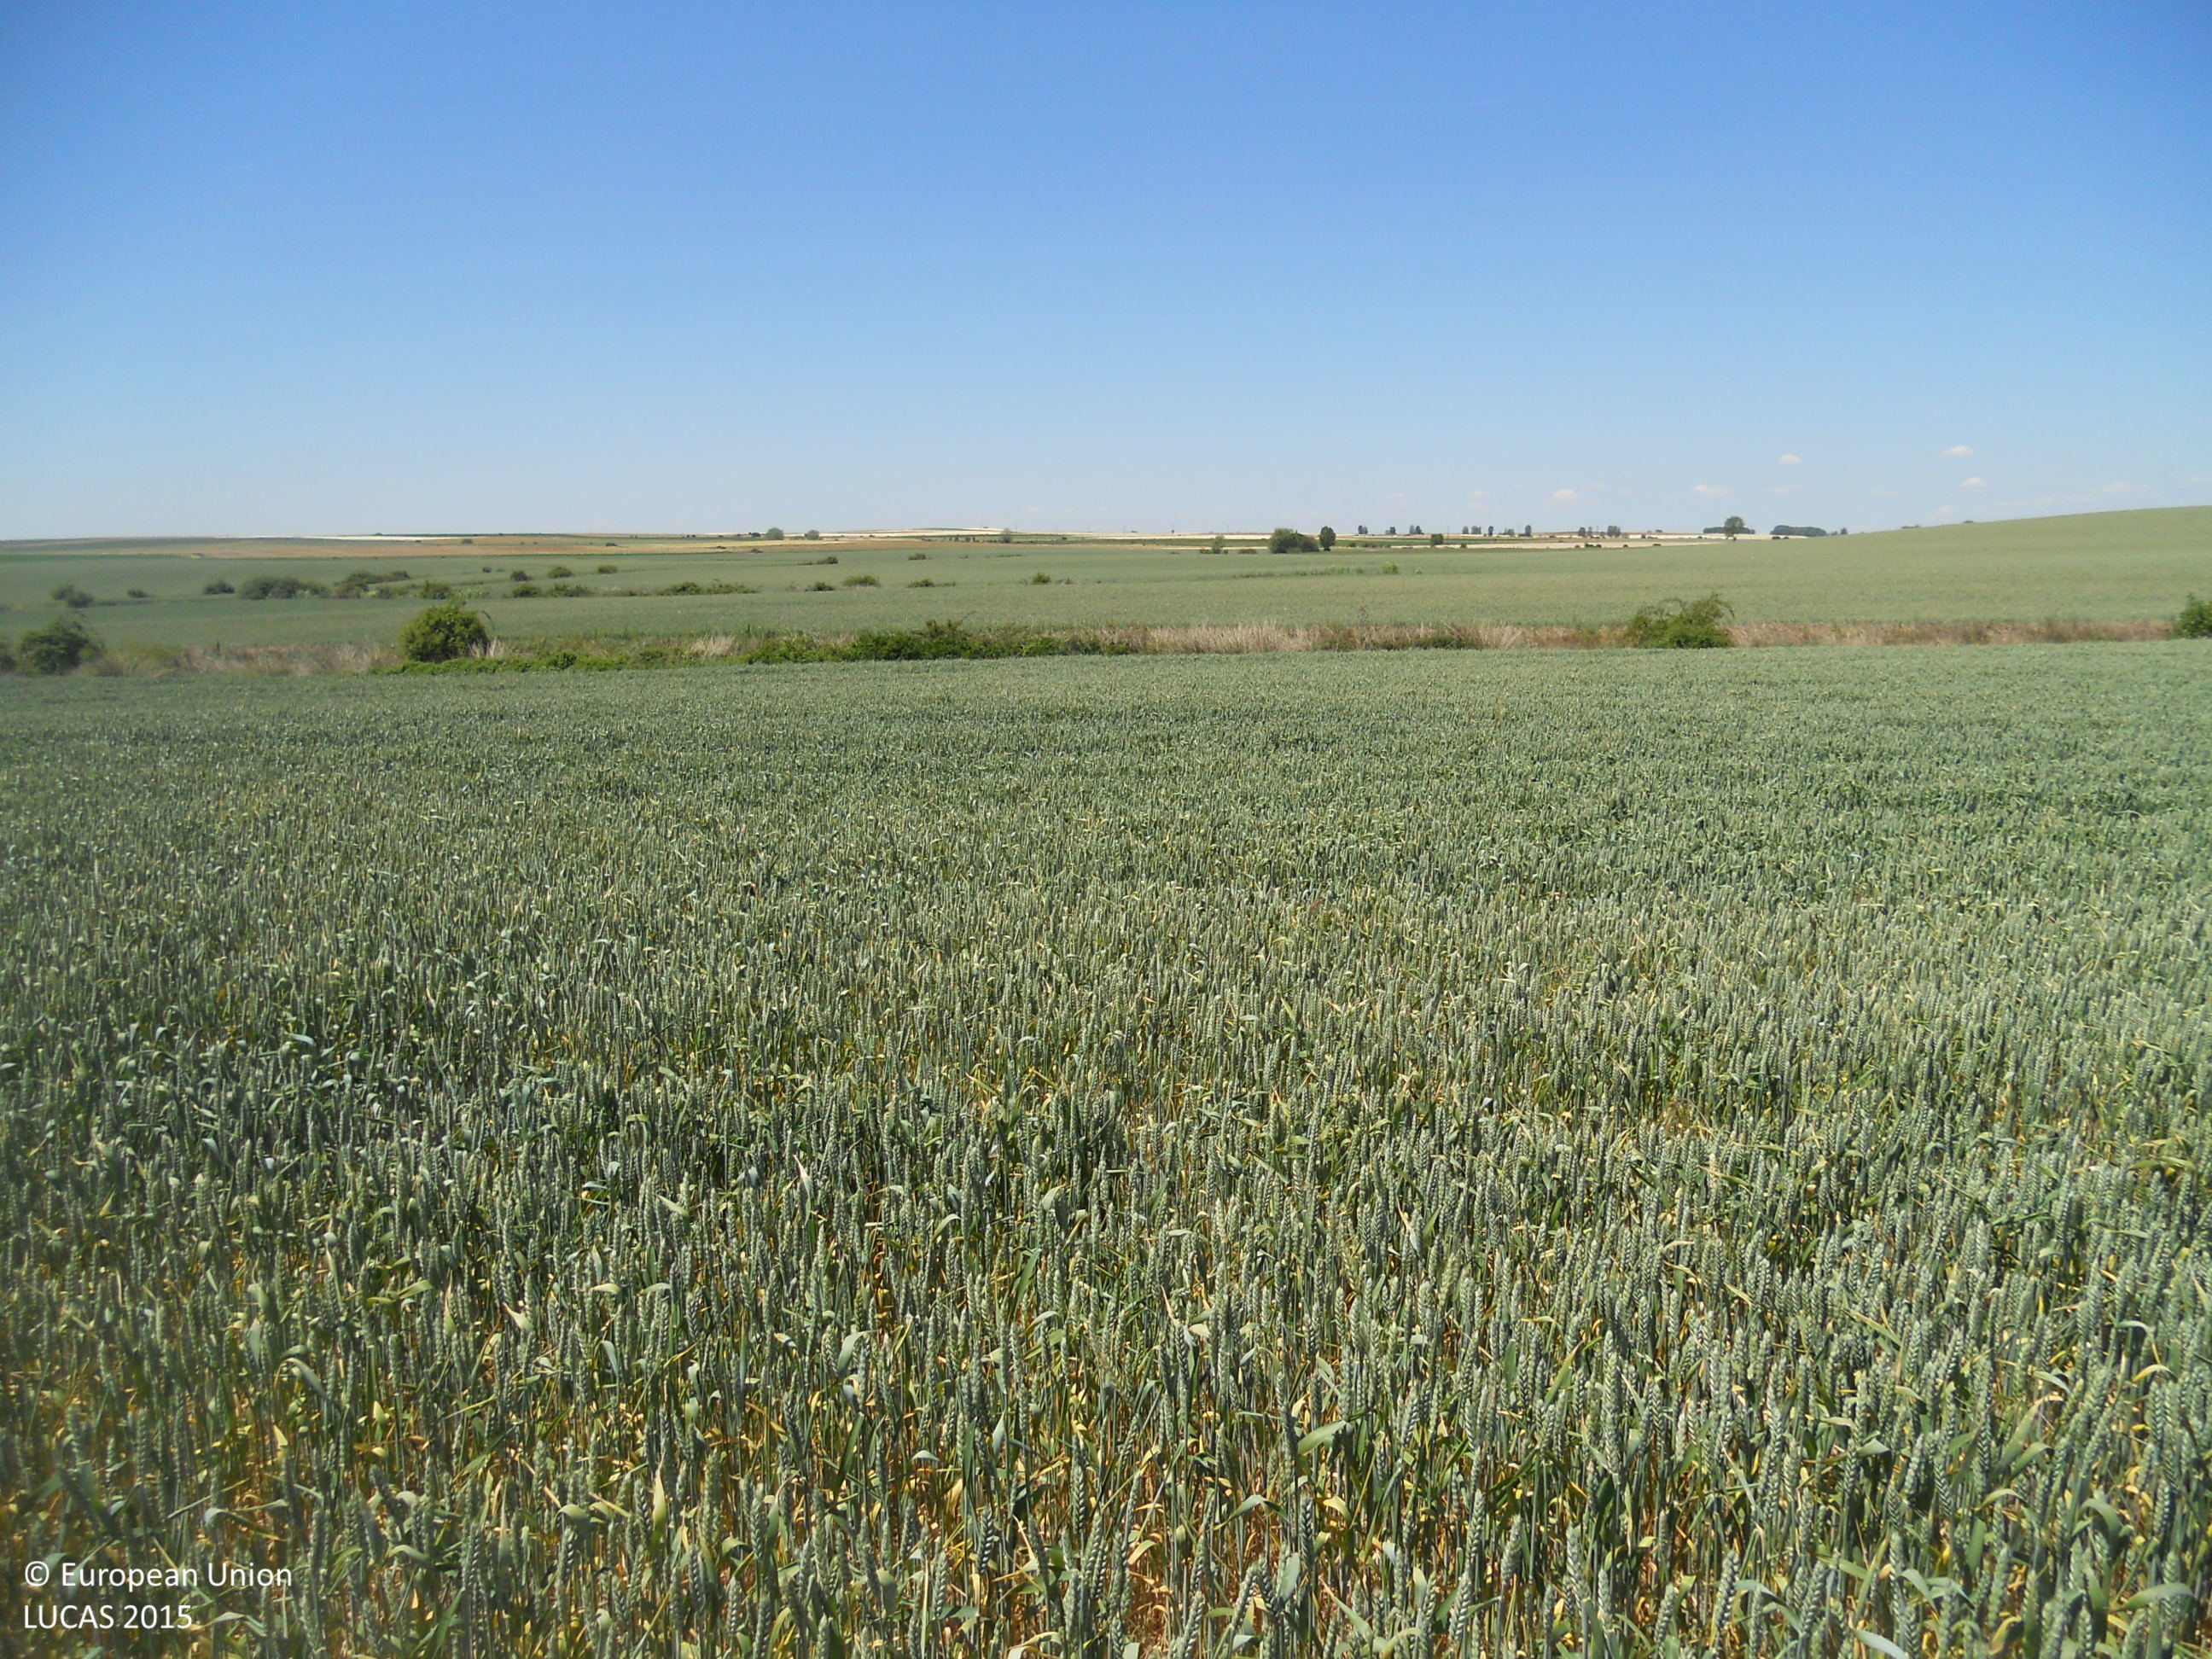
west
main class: Cropland
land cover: Common wheat
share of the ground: > 75 %
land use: Agriculture (excluding fallow land and kitchen gardens)
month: May
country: ES
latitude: 42.2803
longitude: -4.7623
